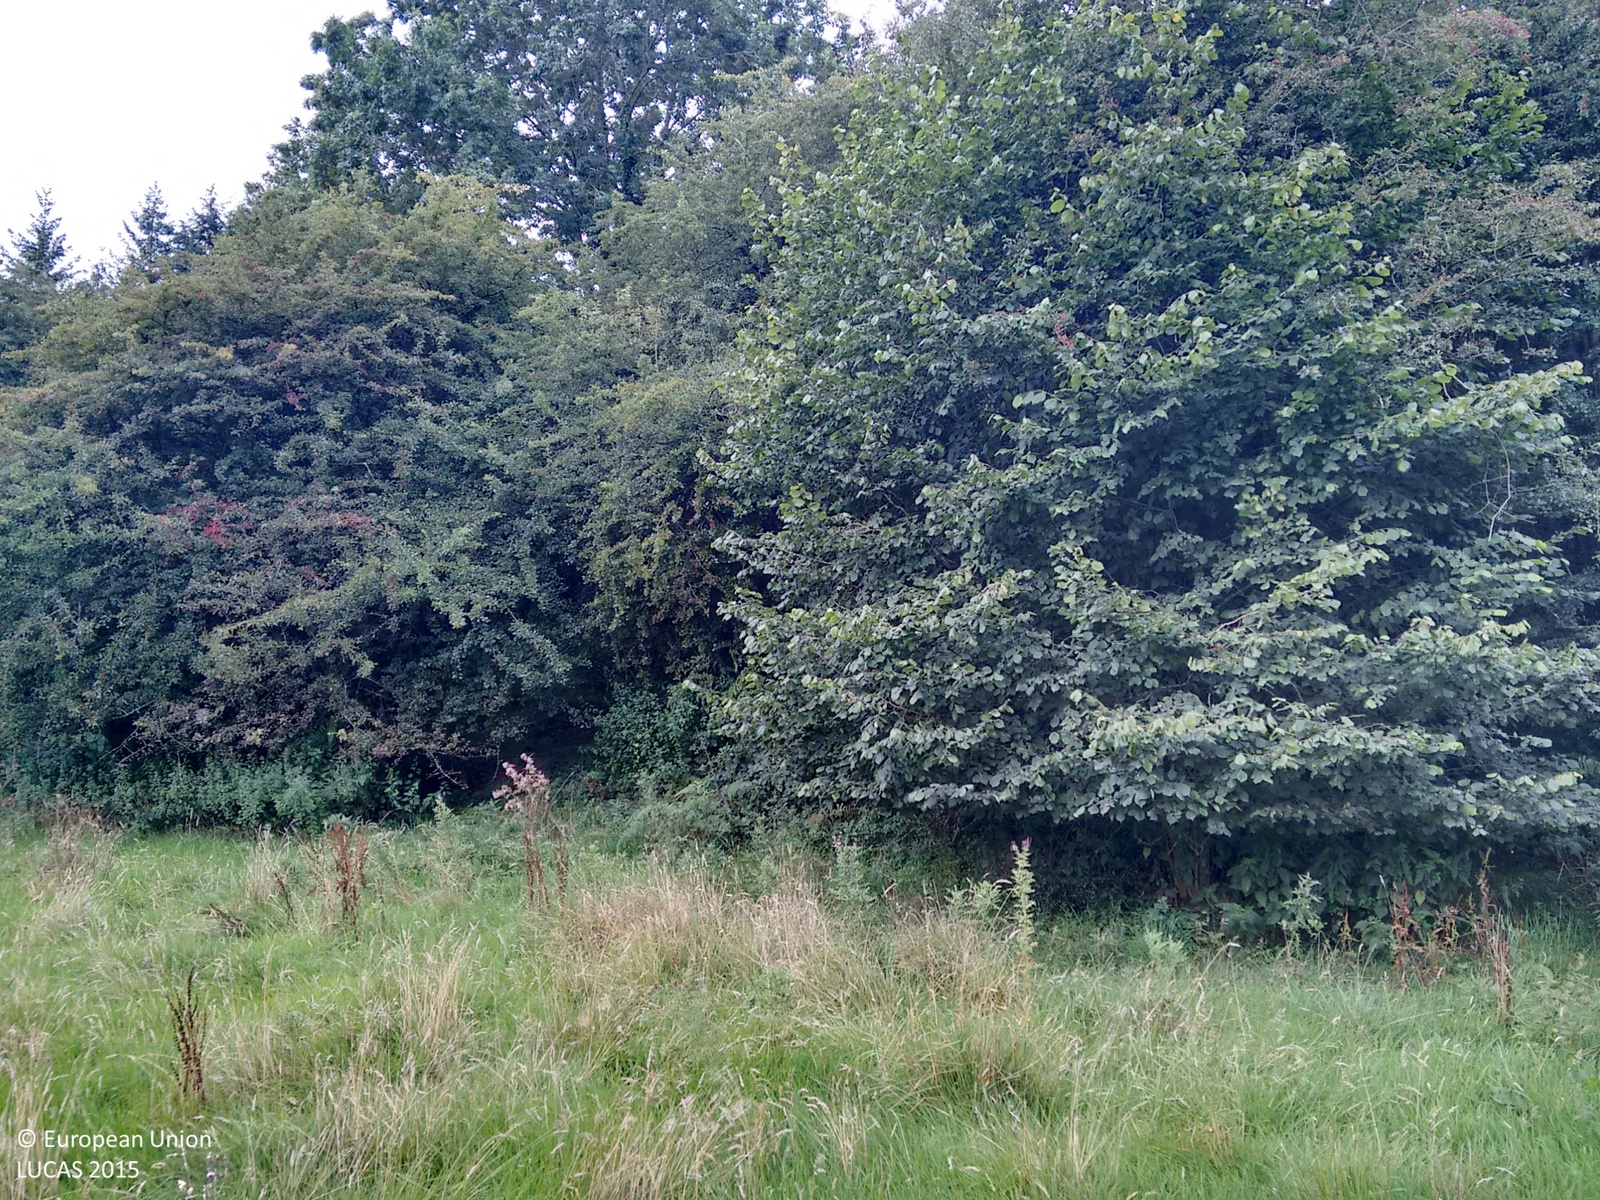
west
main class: Grassland
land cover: Grassland with sparse tree/shrub cover
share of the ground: > 75 %
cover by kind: herbaceous plants 95 %, broadleaved forest trees 5 %
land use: Semi-natural and natural areas not in use
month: September
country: GB
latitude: 52.2275
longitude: -3.4501
